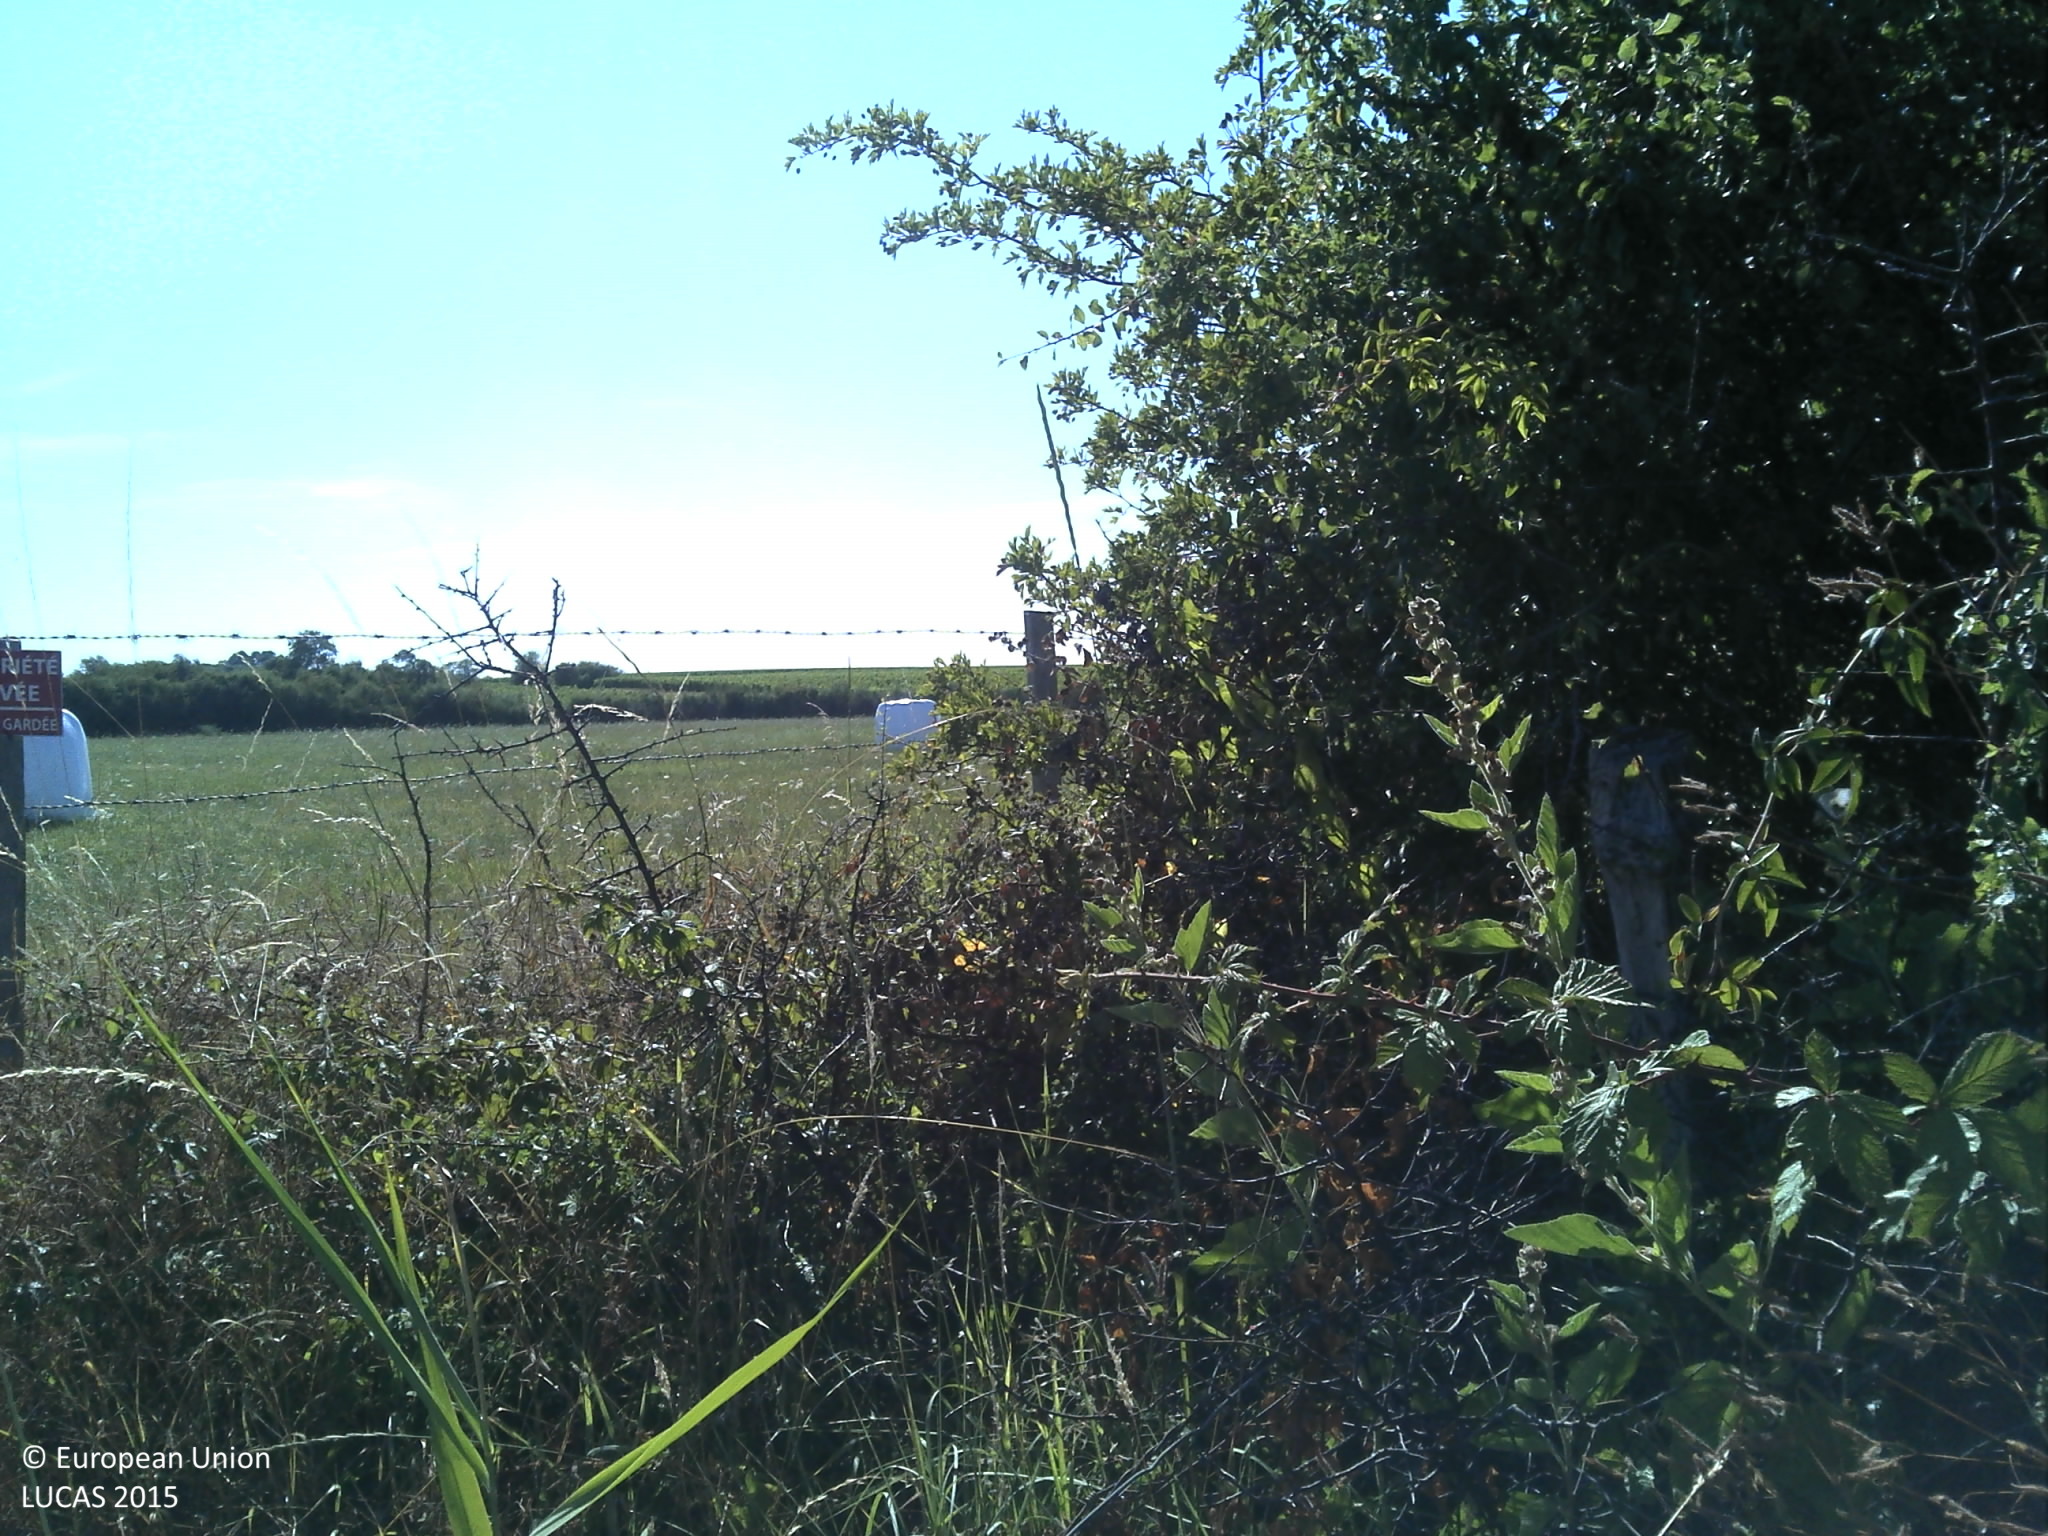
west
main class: Grassland
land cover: Grassland without tree/shrub cover
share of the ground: > 75 %
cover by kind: herbaceous plants 100 %
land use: Agriculture (excluding fallow land and kitchen gardens)
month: July
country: FR
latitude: 45.3476
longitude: -0.8087
